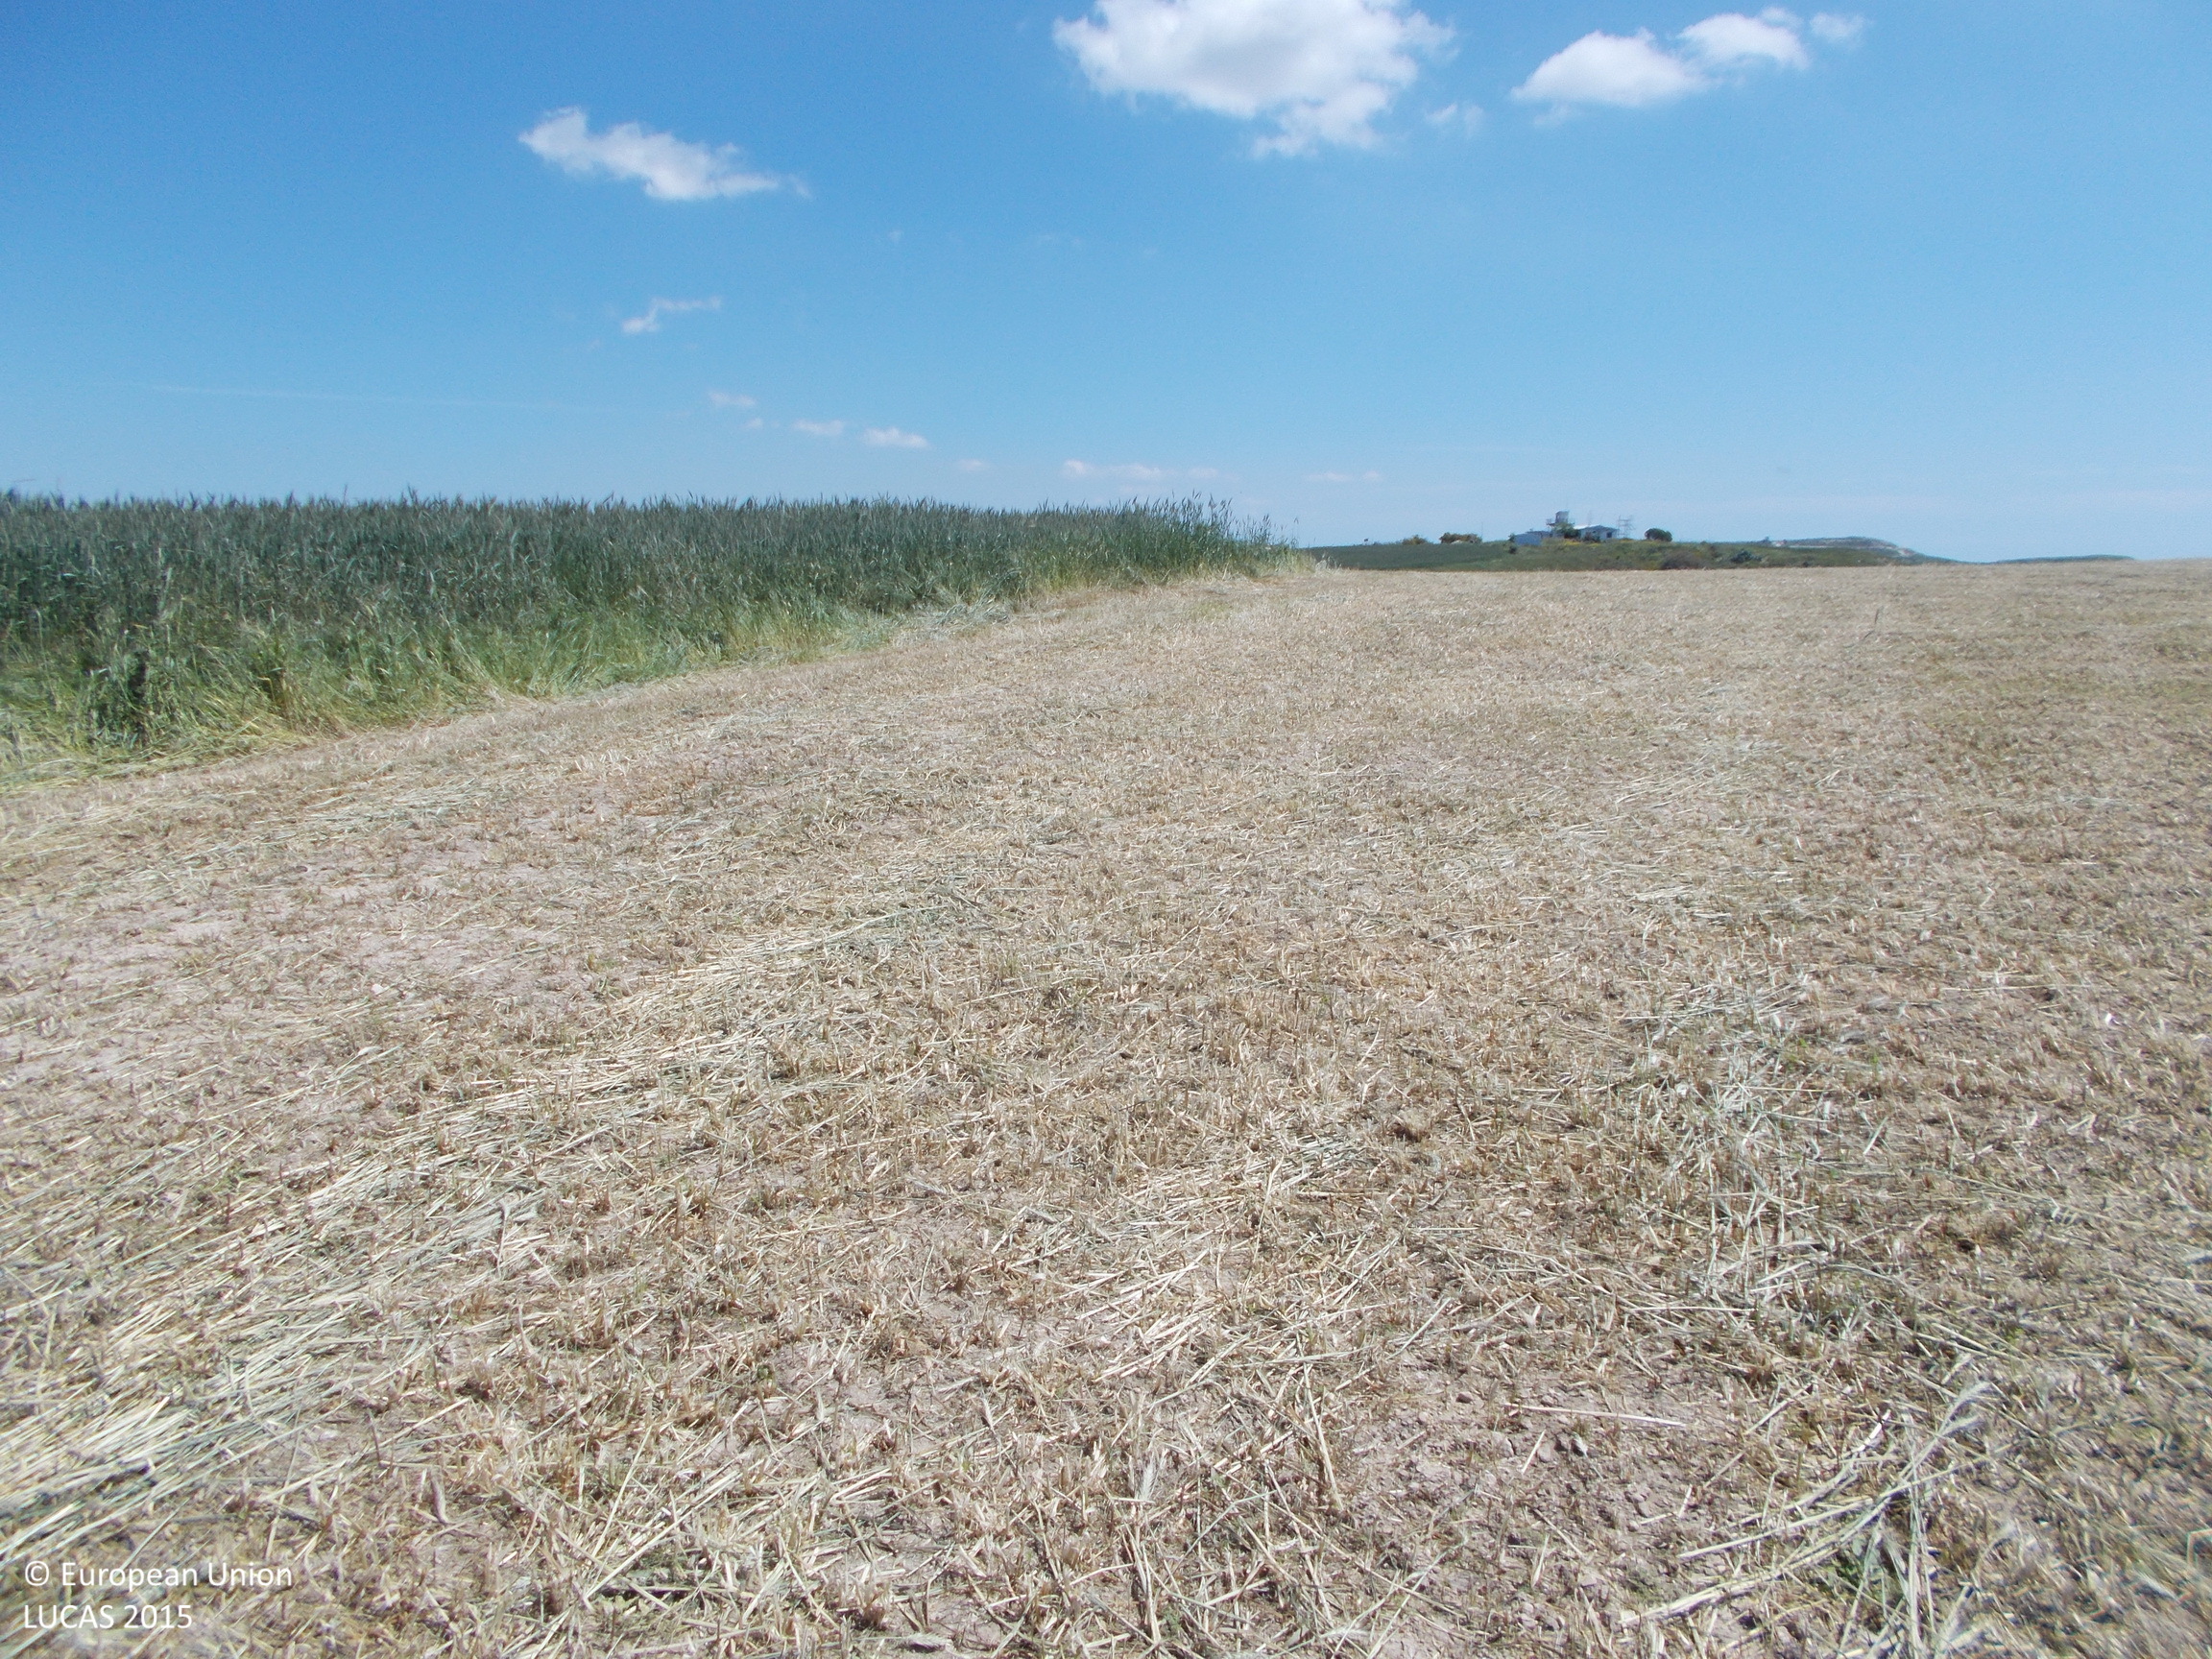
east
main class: Cropland
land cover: Barley
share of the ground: < 10 %
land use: Agriculture (excluding fallow land and kitchen gardens)
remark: Harvested field
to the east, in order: Barley; Spontaneously vegetated surfaces; Mixed cereals for fodder; Barley; Paved roads, cycling and walking lanes; Spontaneously vegetated surfaces; Mixed cereals for fodder
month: April
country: CY
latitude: 35.0434
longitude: 33.5591
